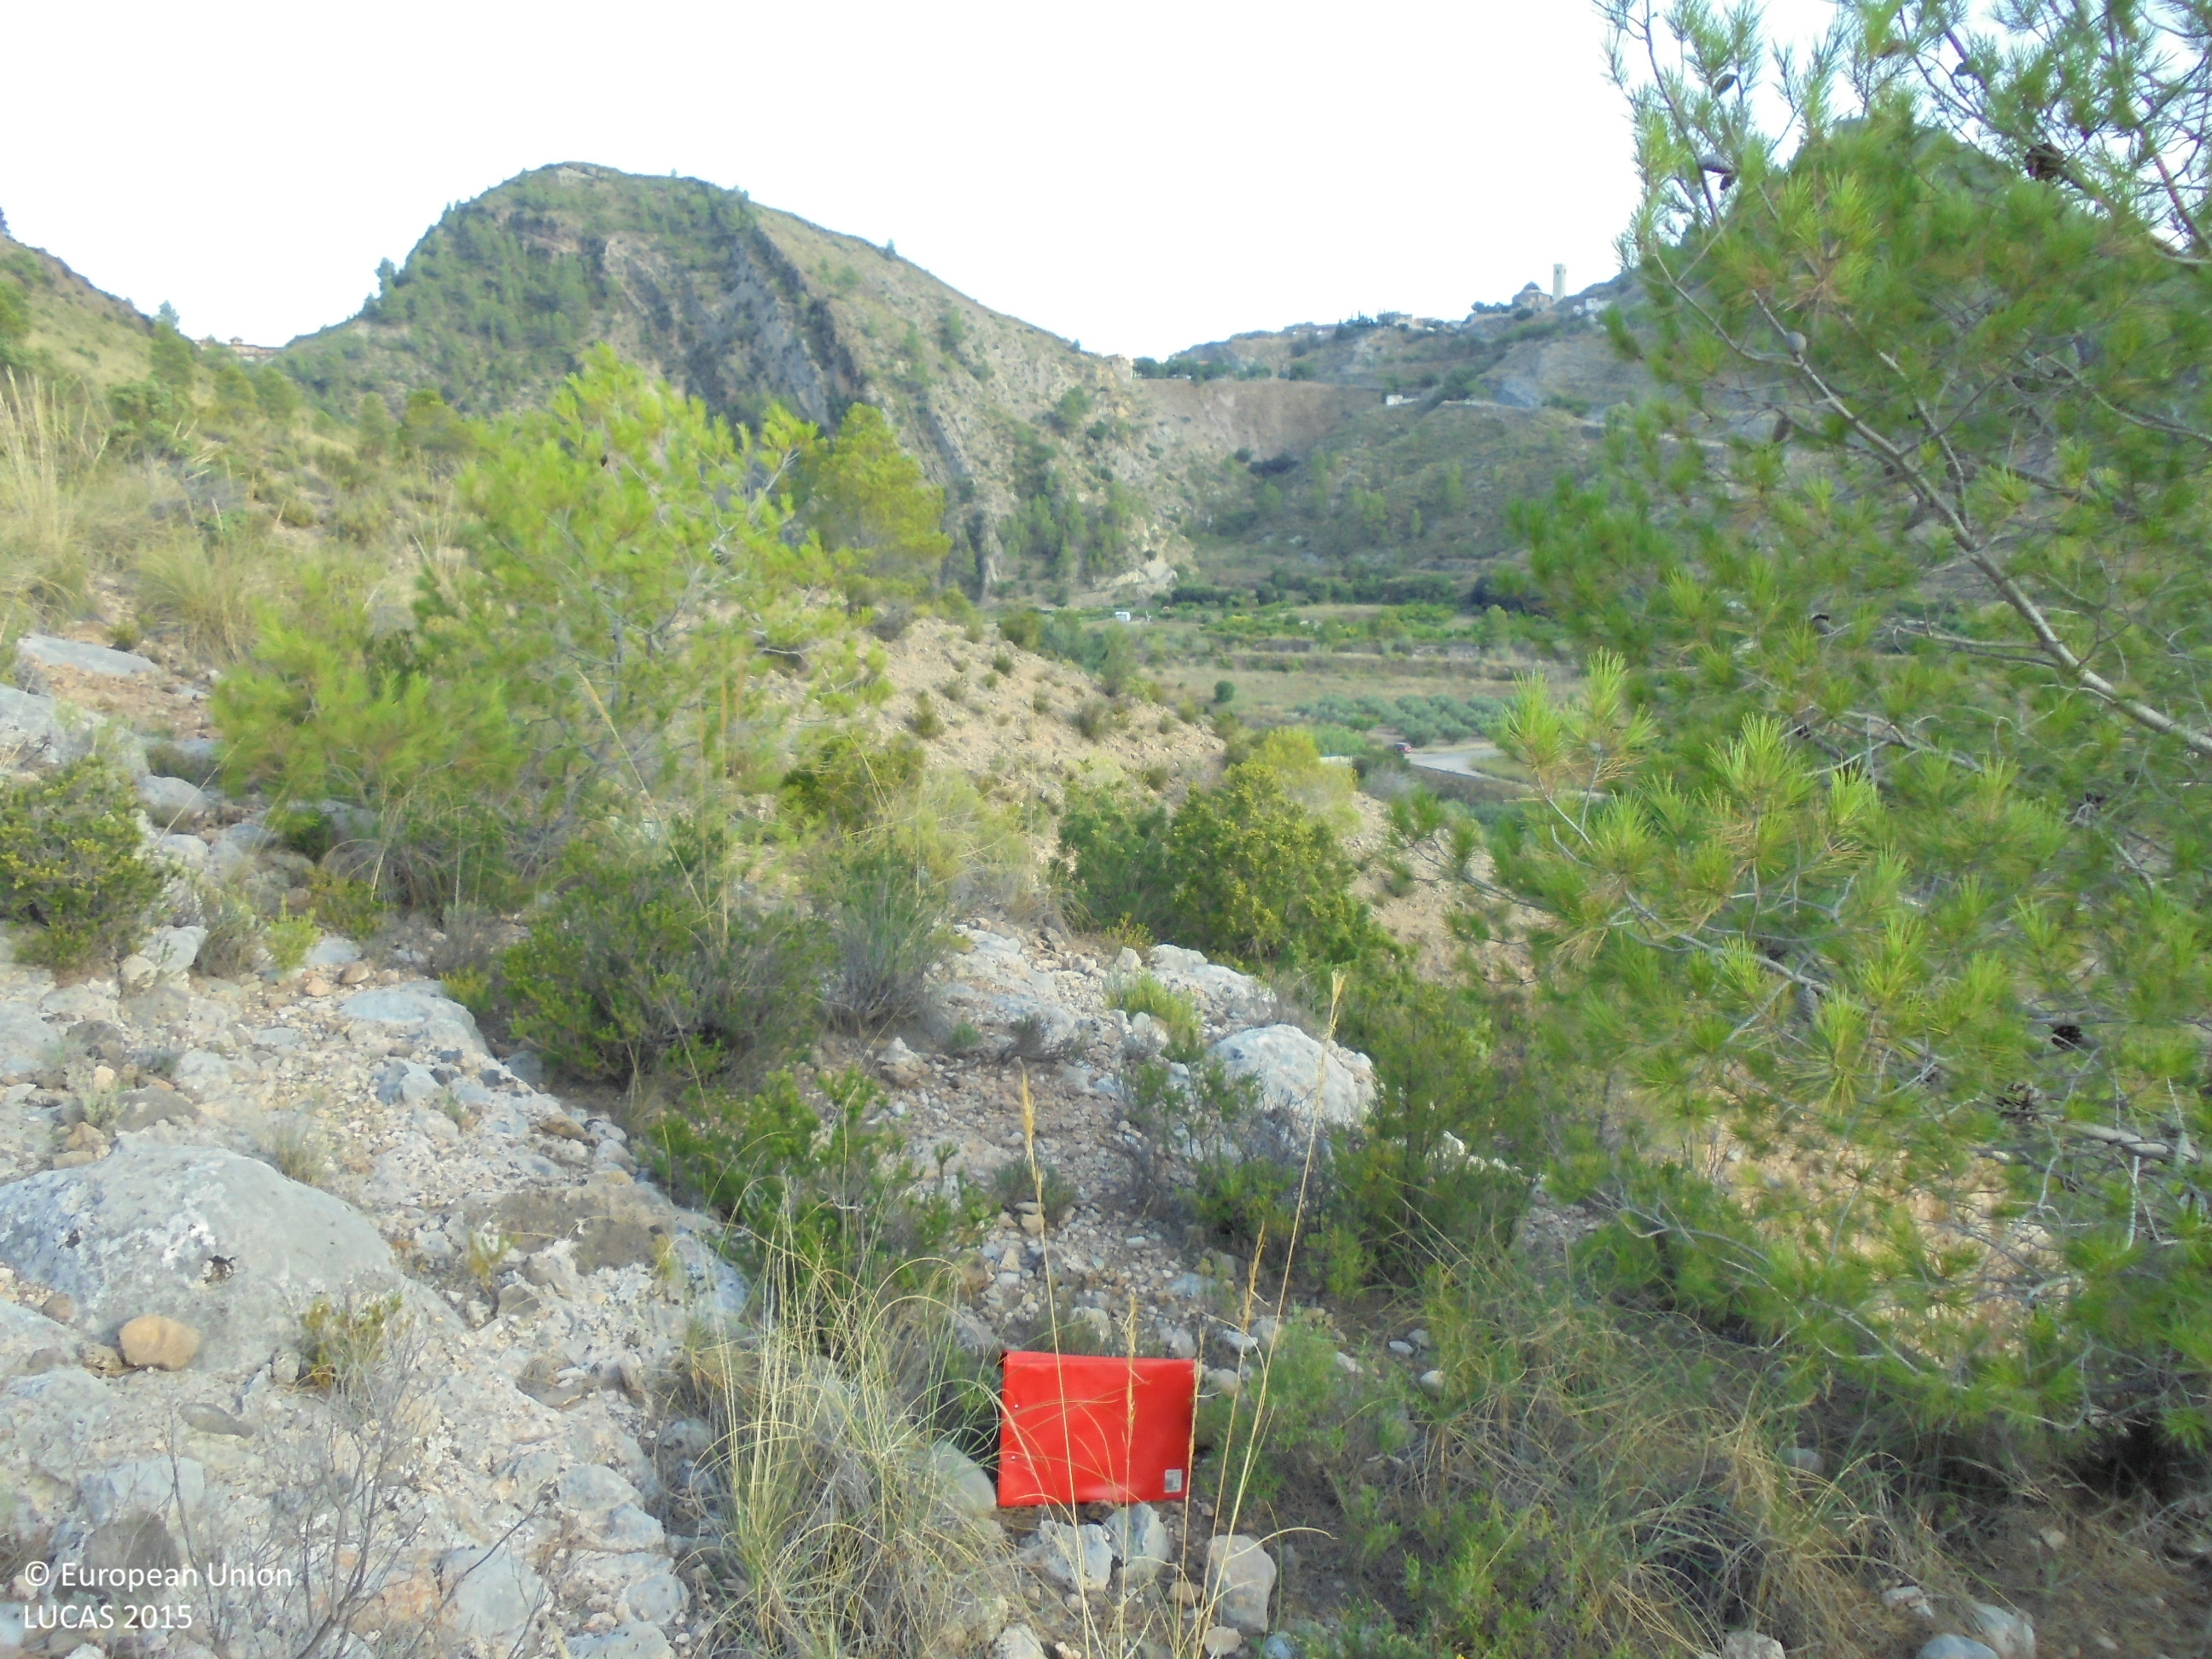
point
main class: Shrubland
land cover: Shrubland with sparse tree cover
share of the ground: > 75 %
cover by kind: shrubs 80 %, unconsolidated bare surface 15 %, coniferous forest trees 5 %
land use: Semi-natural and natural areas not in use
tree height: > 5 m
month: August
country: ES
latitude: 39.1997
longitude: -1.0793
